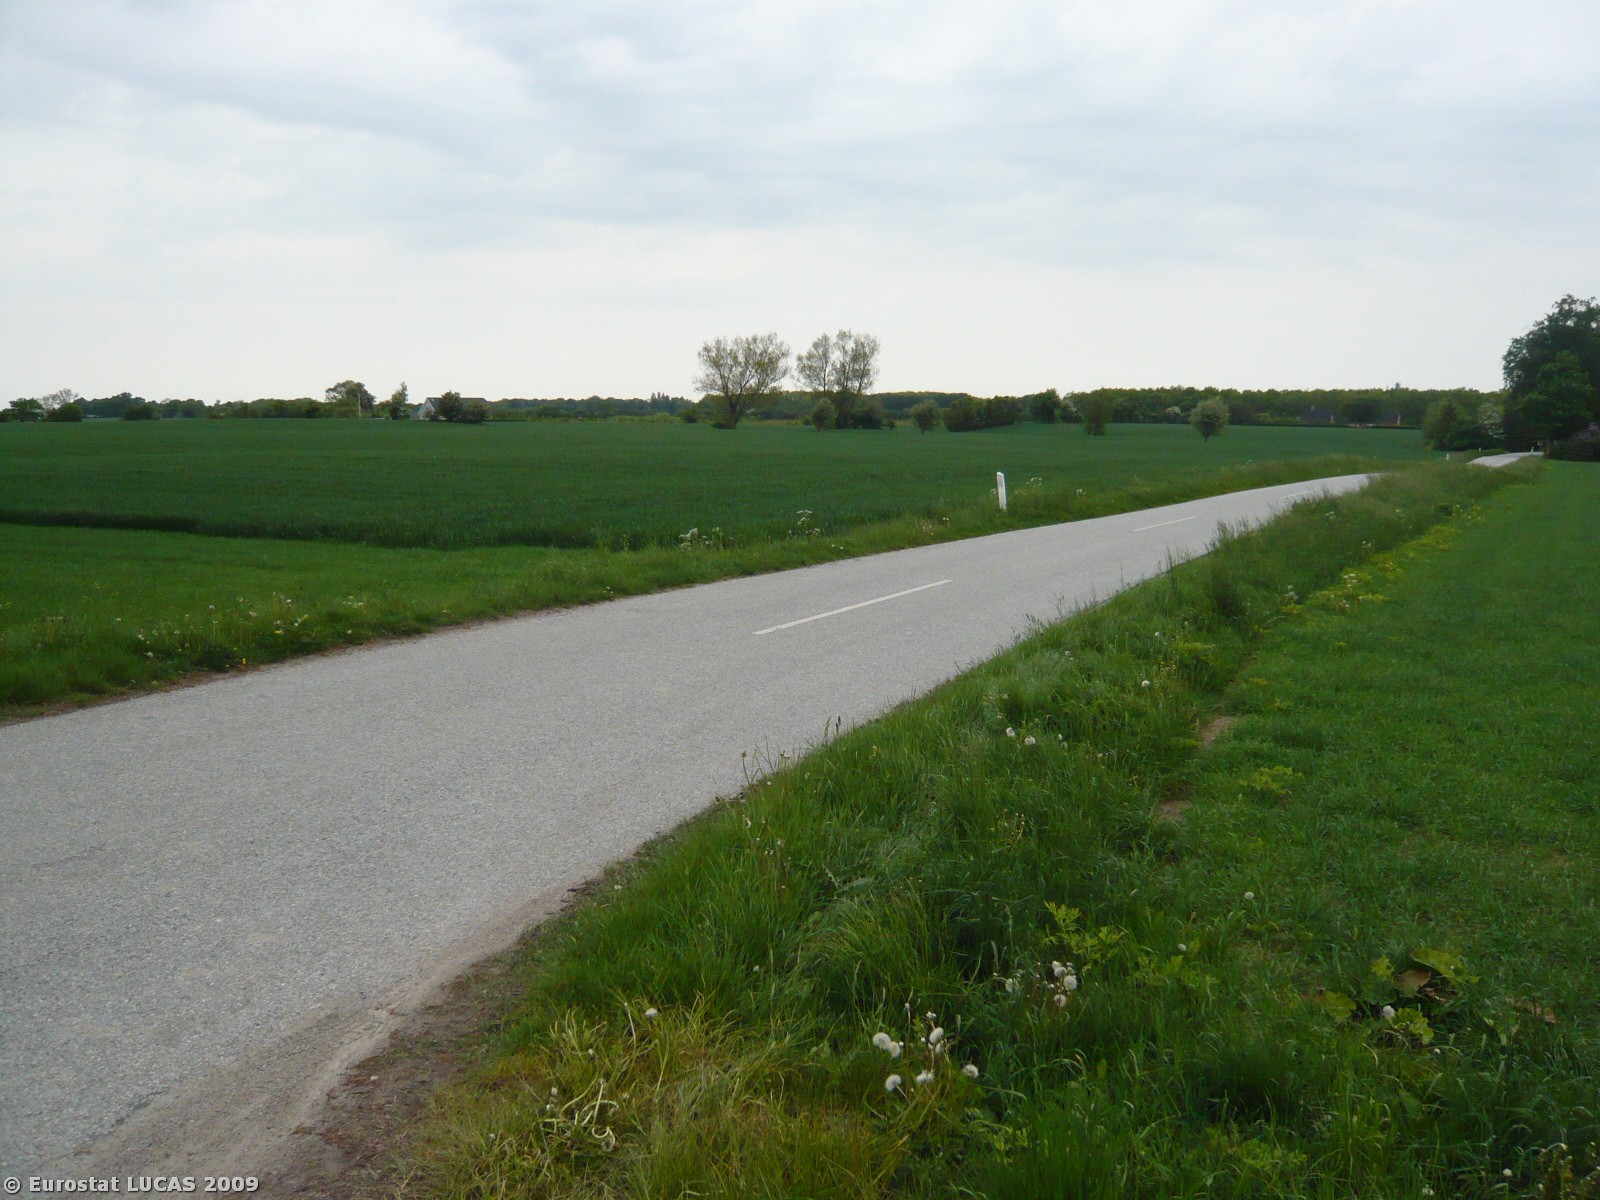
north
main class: Shrubland
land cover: Shrubland with sparse tree cover
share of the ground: 25 - 50 %
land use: Agriculture (excluding fallow land and kitchen gardens)
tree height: > 5 m
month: May
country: DK
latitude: 55.3999
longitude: 11.9407
